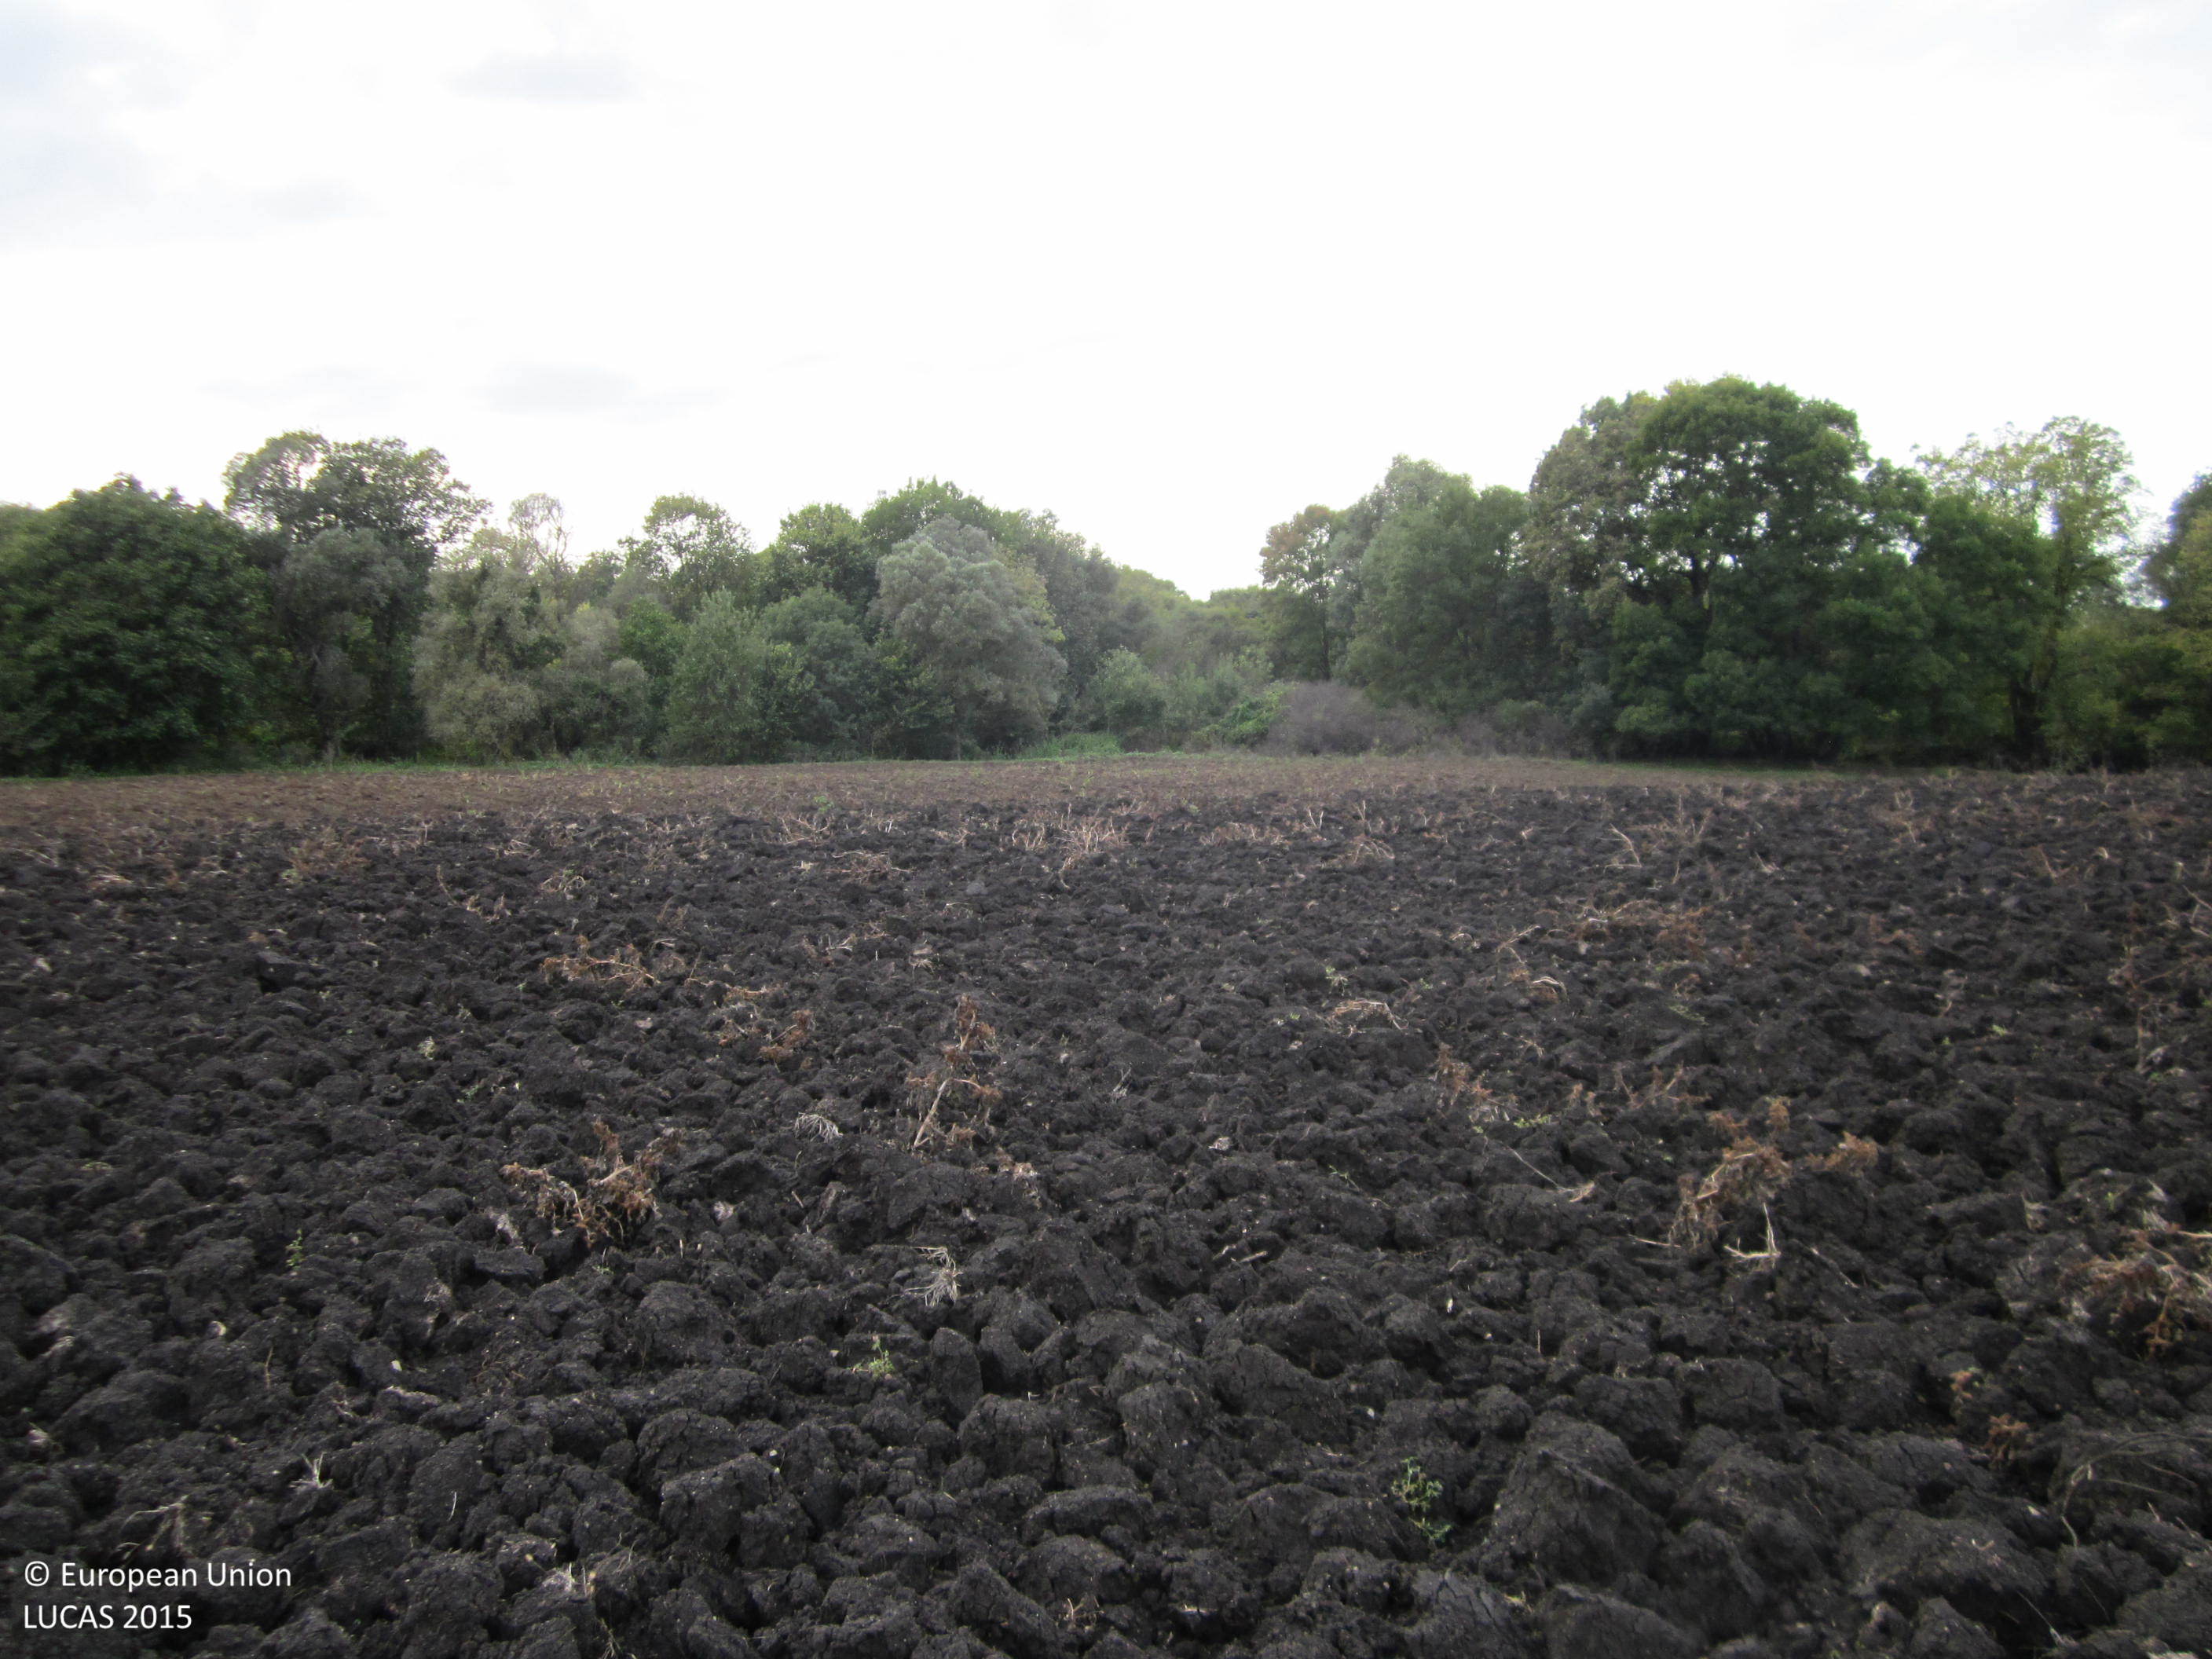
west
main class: Cropland
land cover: Common wheat
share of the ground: < 10 %
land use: Agriculture (excluding fallow land and kitchen gardens)
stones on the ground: < 10 %
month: October
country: BG
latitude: 42.3752
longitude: 27.0456
